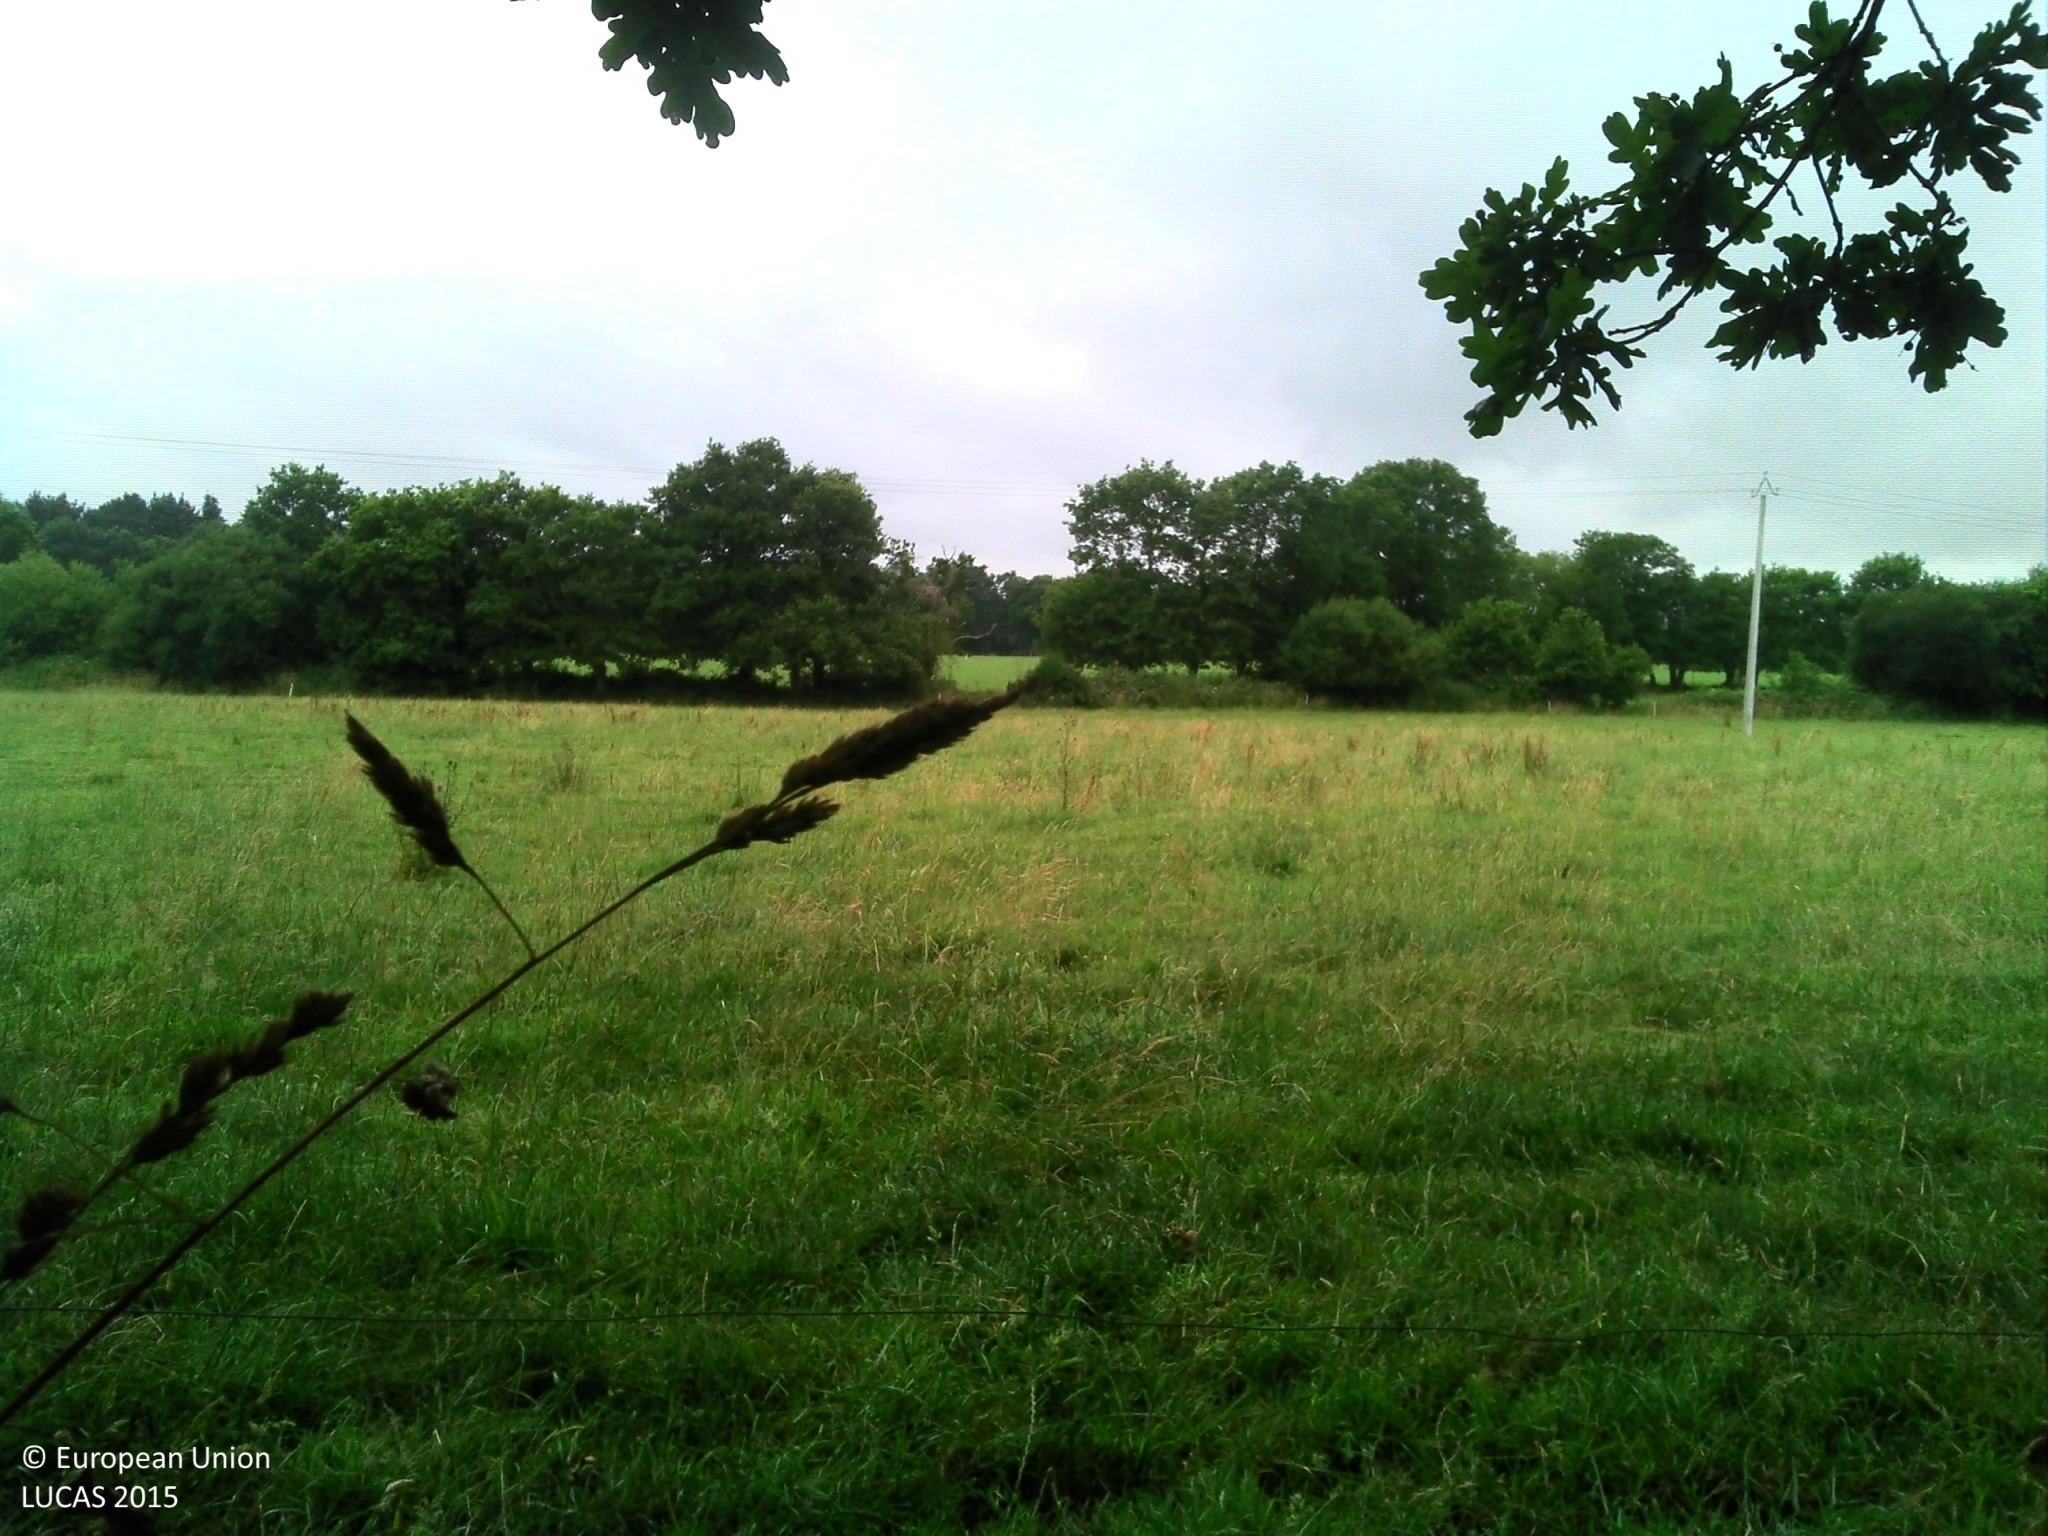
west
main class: Woodland
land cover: Broadleaved woodland
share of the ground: > 75 %
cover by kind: broadleaved forest trees 70 %, herbaceous plants 30 %
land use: Forestry
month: July
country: FR
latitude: 48.2742
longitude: -2.0047
